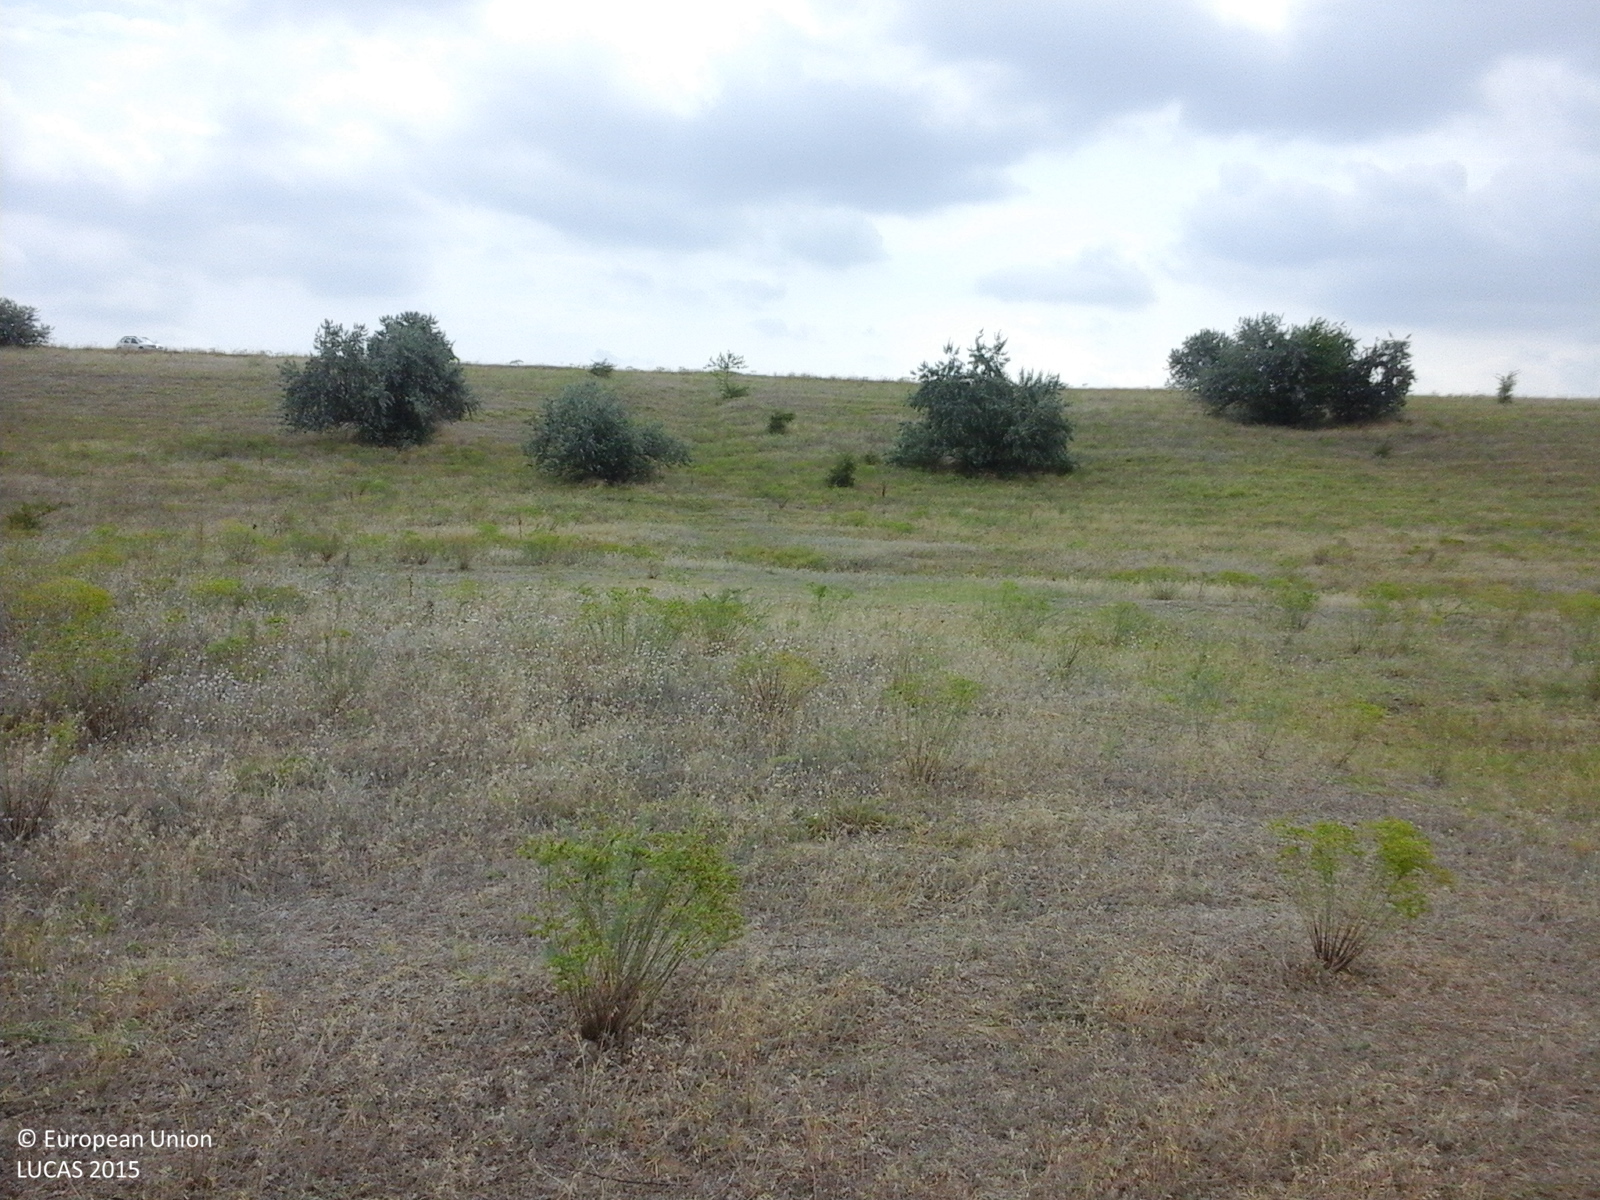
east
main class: Grassland
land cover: Grassland without tree/shrub cover
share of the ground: > 75 %
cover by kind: herbaceous plants 100 %
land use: Agriculture (excluding fallow land and kitchen gardens)
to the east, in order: Grassland without tree/shrub cover; Grassland with sparse tree/shrub cover; Common wheat; Grass margins; Tracks; Grass margins; Sunflower
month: July
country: RO
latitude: 44.9818
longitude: 28.1641
